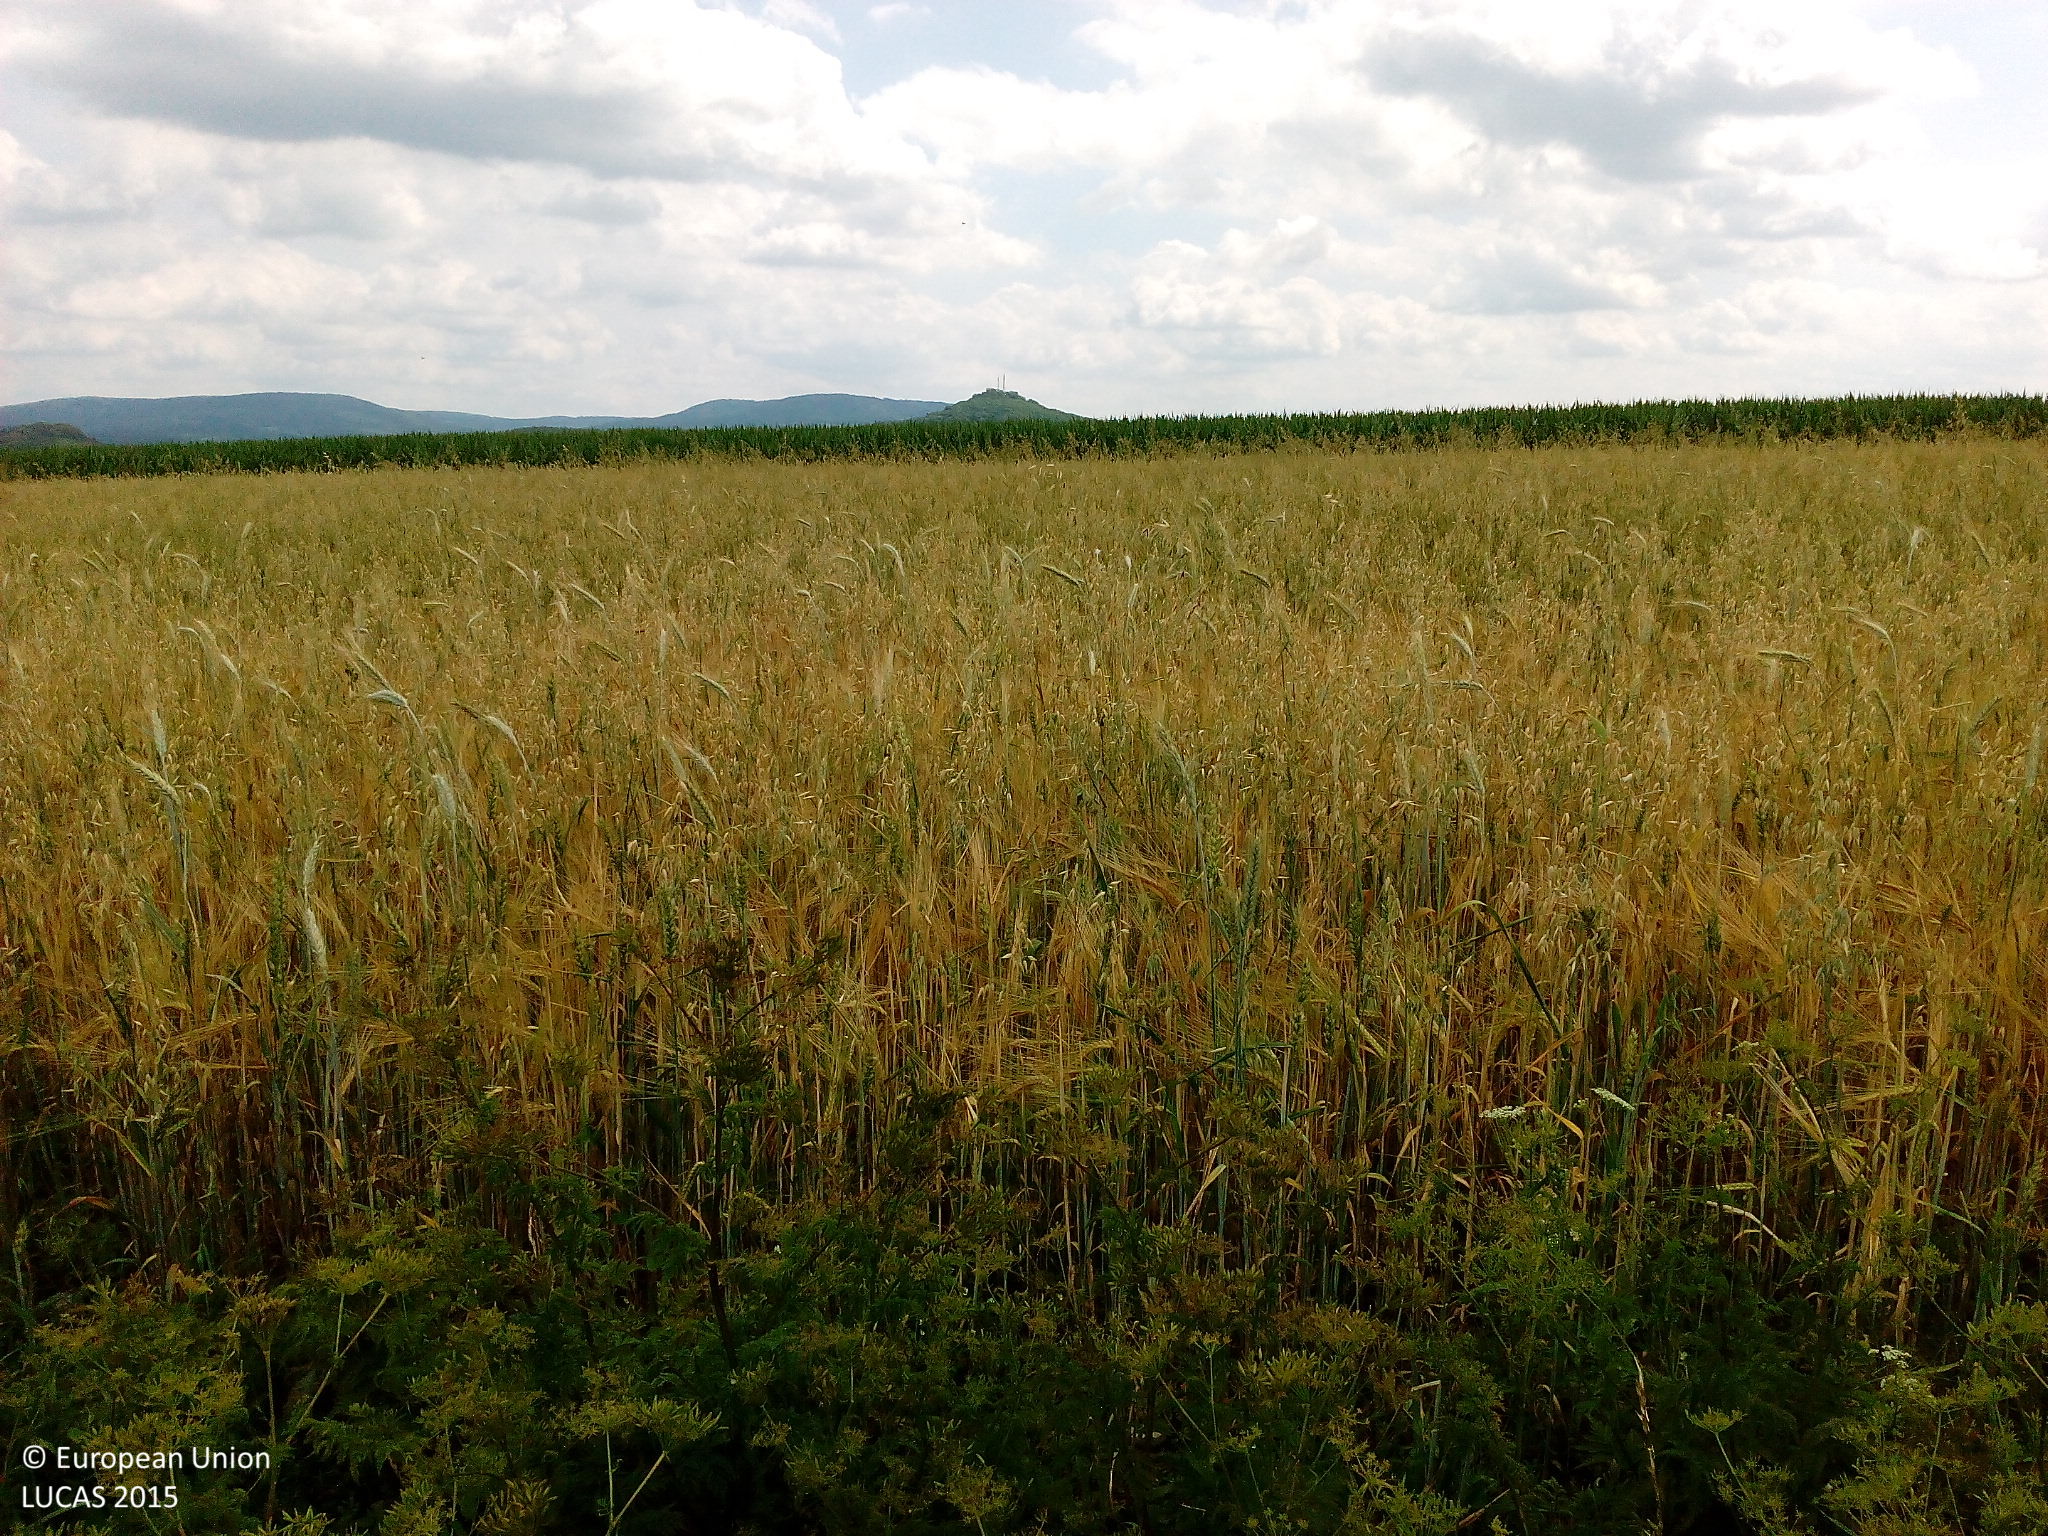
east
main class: Cropland
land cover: Mixed cereals for fodder
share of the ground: > 75 %
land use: Agriculture (excluding fallow land and kitchen gardens)
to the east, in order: Mixed cereals for fodder; Maize; Common wheat; Grassland without tree/shrub cover; Tracks; Grass margins; Other leguminous and mixtures for fodder
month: July
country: DE
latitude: 50.6876
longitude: 9.9009
